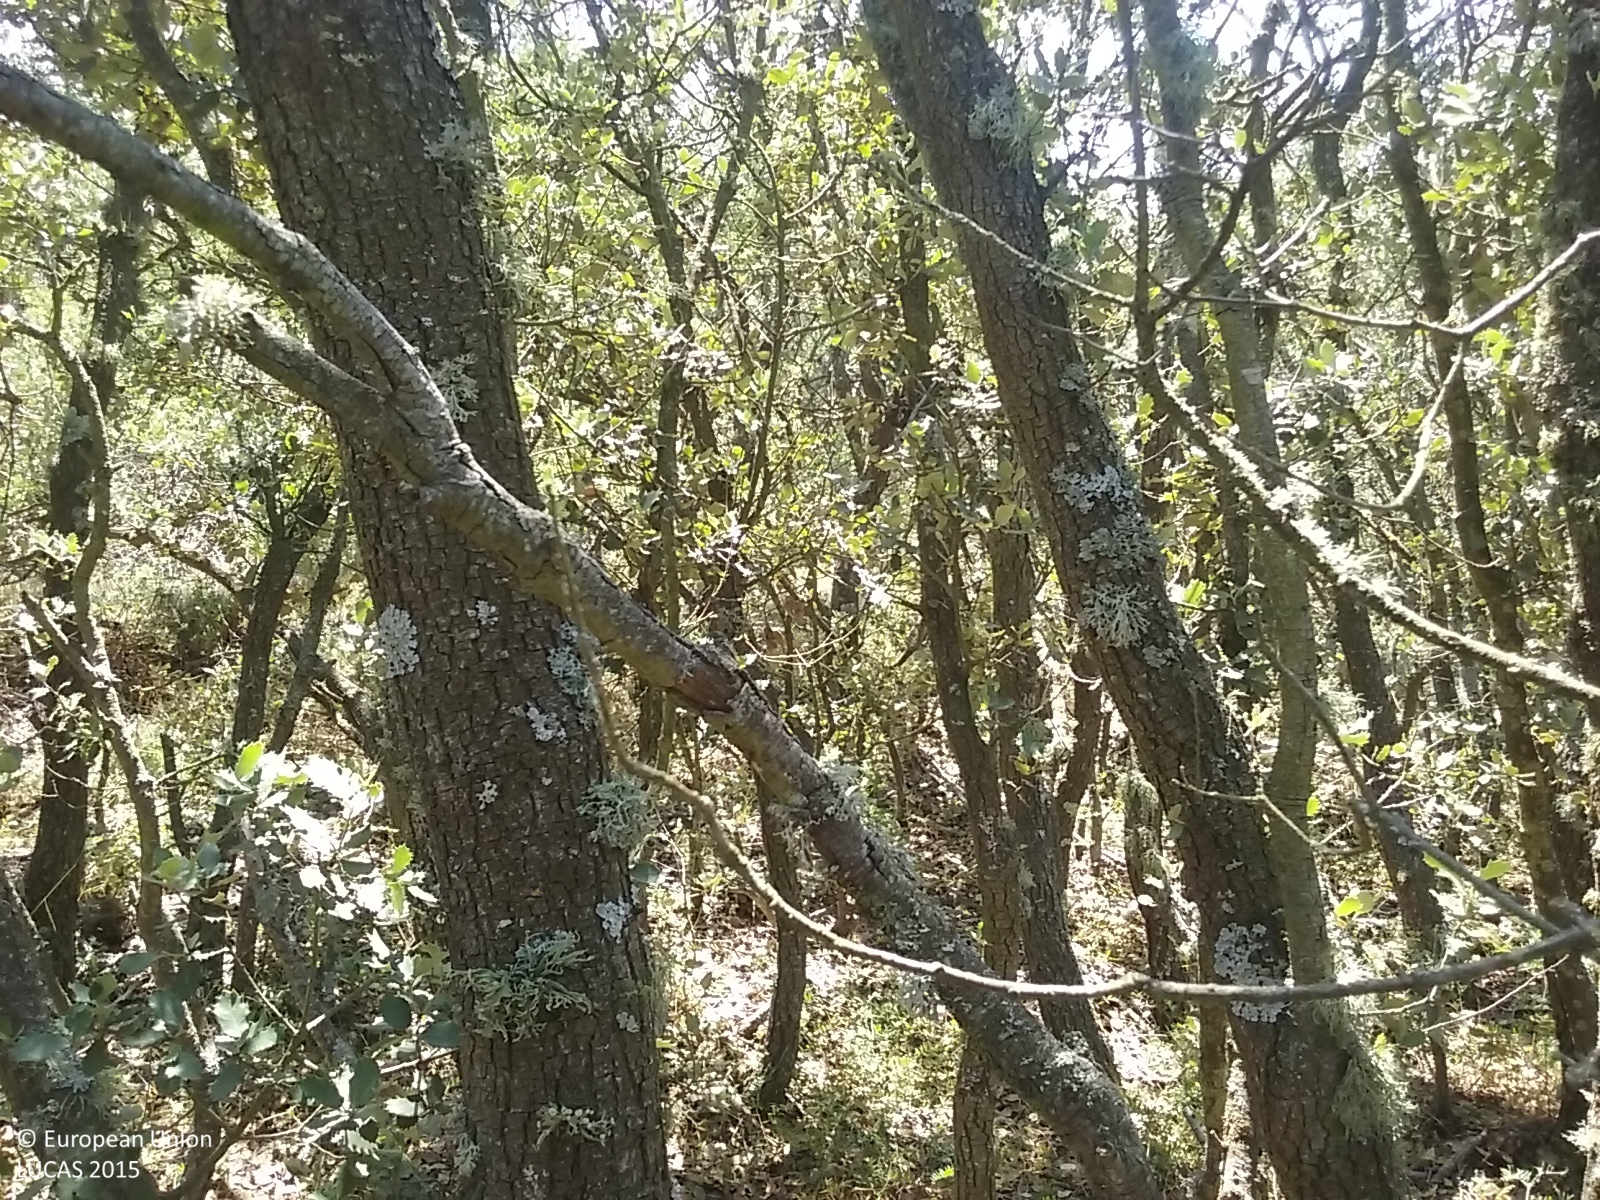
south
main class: Woodland
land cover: Broadleaved woodland
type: broadleaved evergreen forest
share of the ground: > 75 %
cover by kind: broadleaved forest trees 95 %, herbaceous plants 5 %
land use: Semi-natural and natural areas not in use
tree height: < 5 m
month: July
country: ES
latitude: 39.9524
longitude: -0.7143
